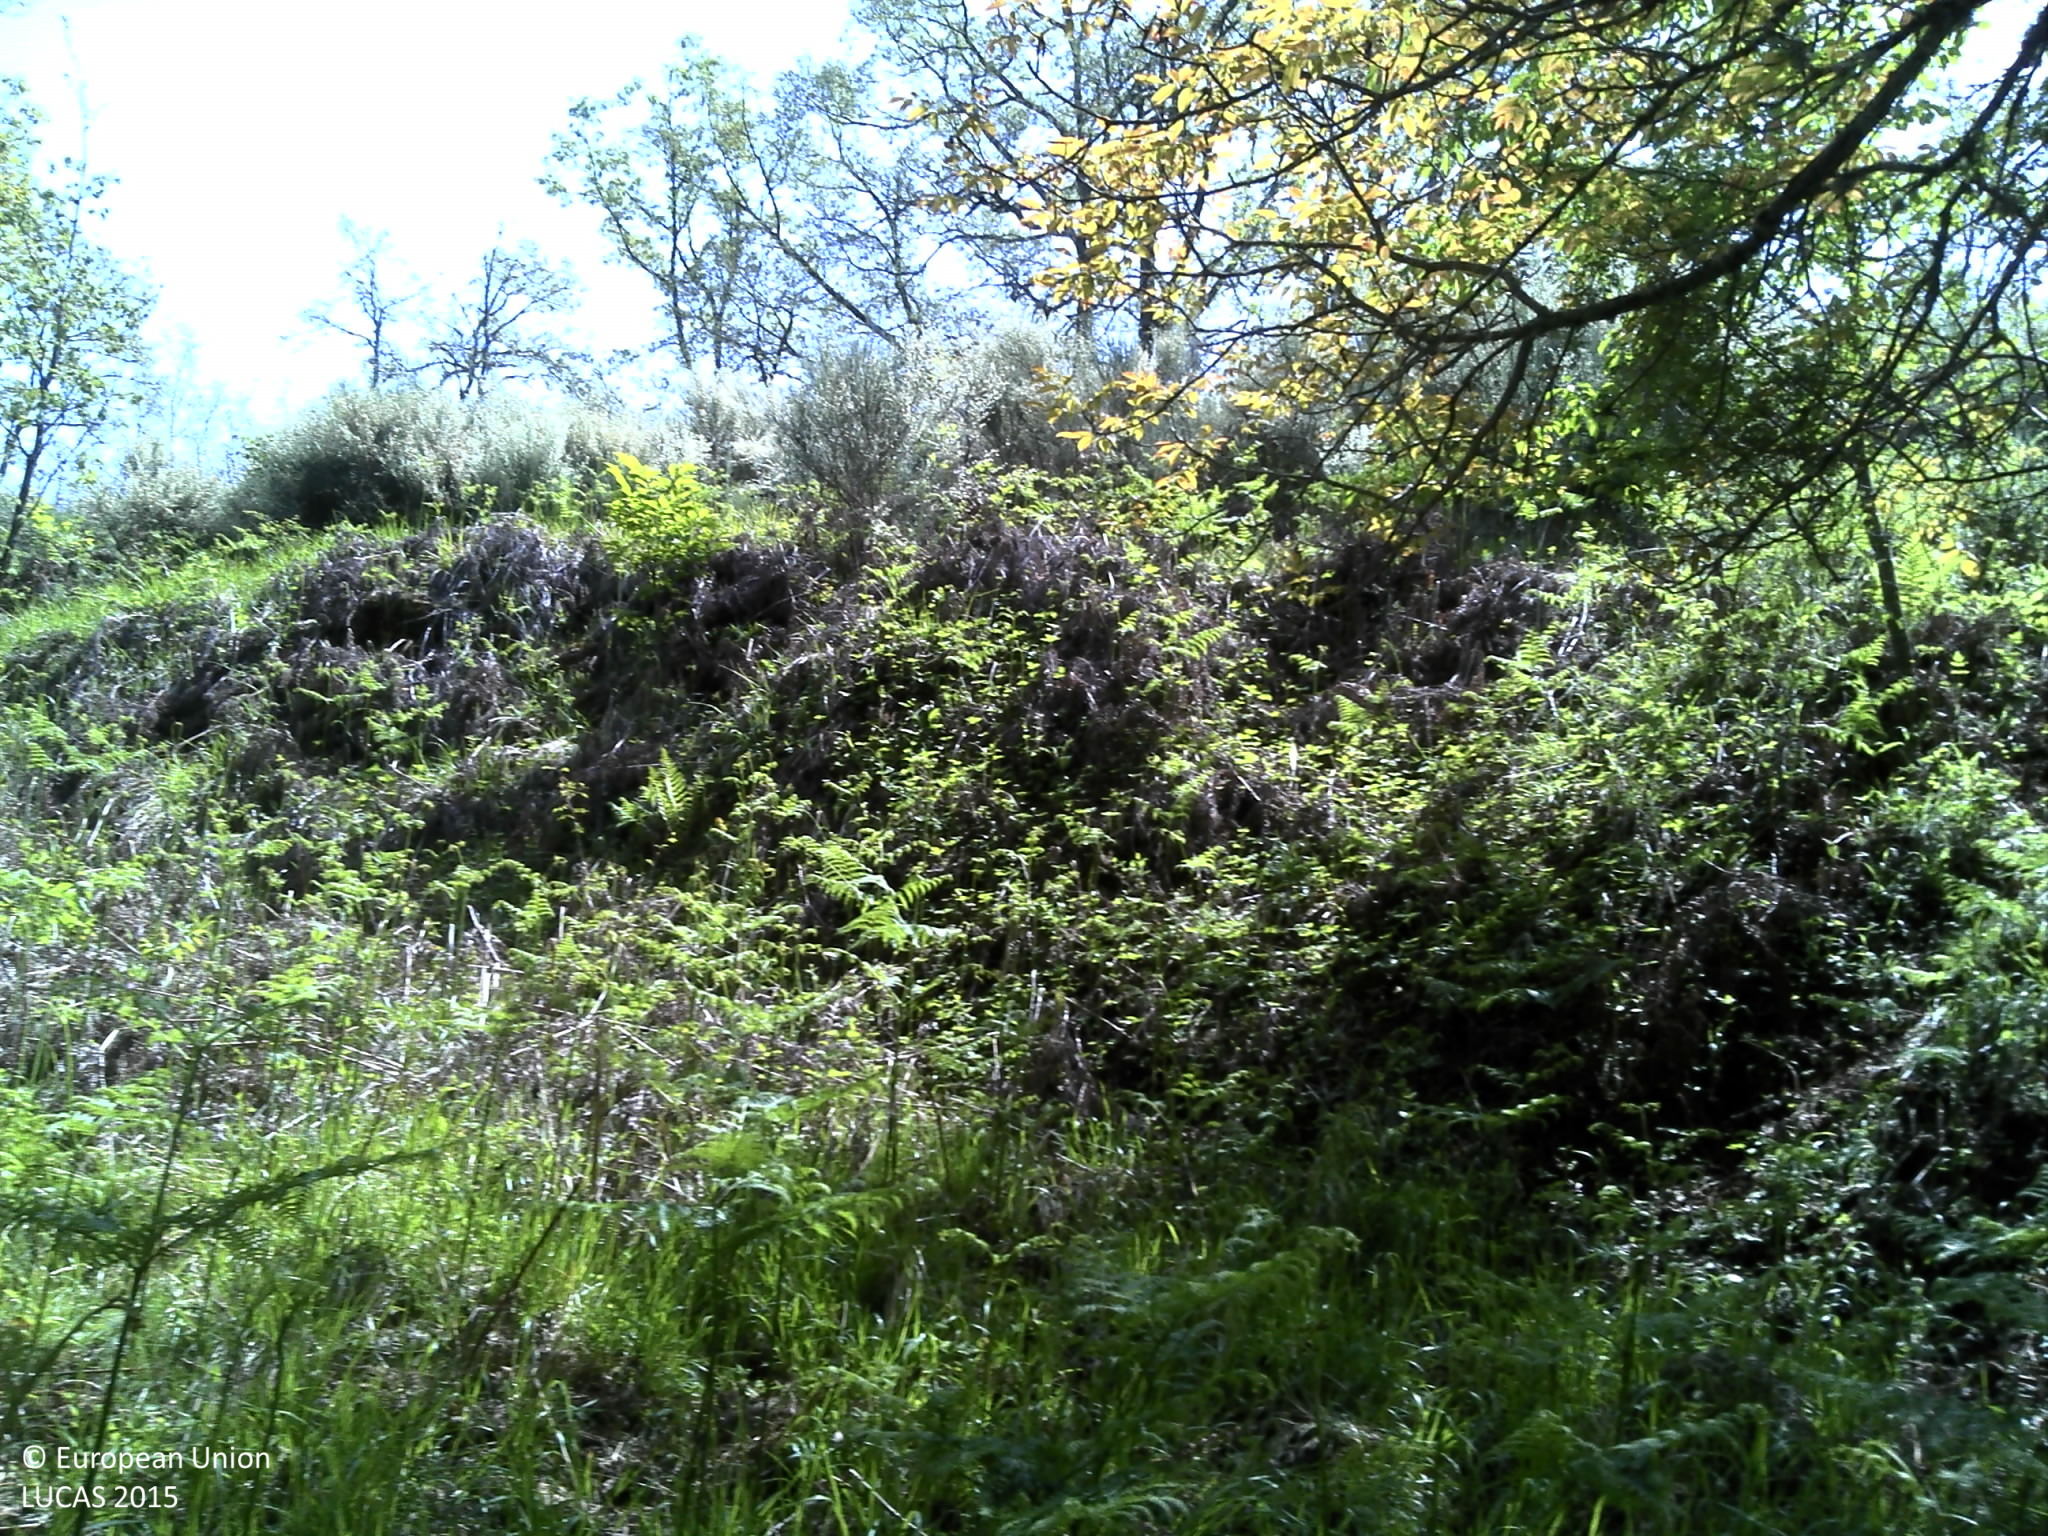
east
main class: Woodland
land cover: Broadleaved woodland
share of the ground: 25 - 50 %
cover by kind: broadleaved forest trees 50 %, unconsolidated bare surface 30 %, shrubs 10 %, herbaceous plants 10 %
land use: Forestry
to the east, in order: Broadleaved woodland; Abandoned hedges; Nuts trees; Grassland without tree/shrub cover; Broadleaved woodland; Grass margins; Tracks; Broadleaved woodland; Grassland without tree/shrub cover
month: May
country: PT
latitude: 41.8811
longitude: -7.0276
